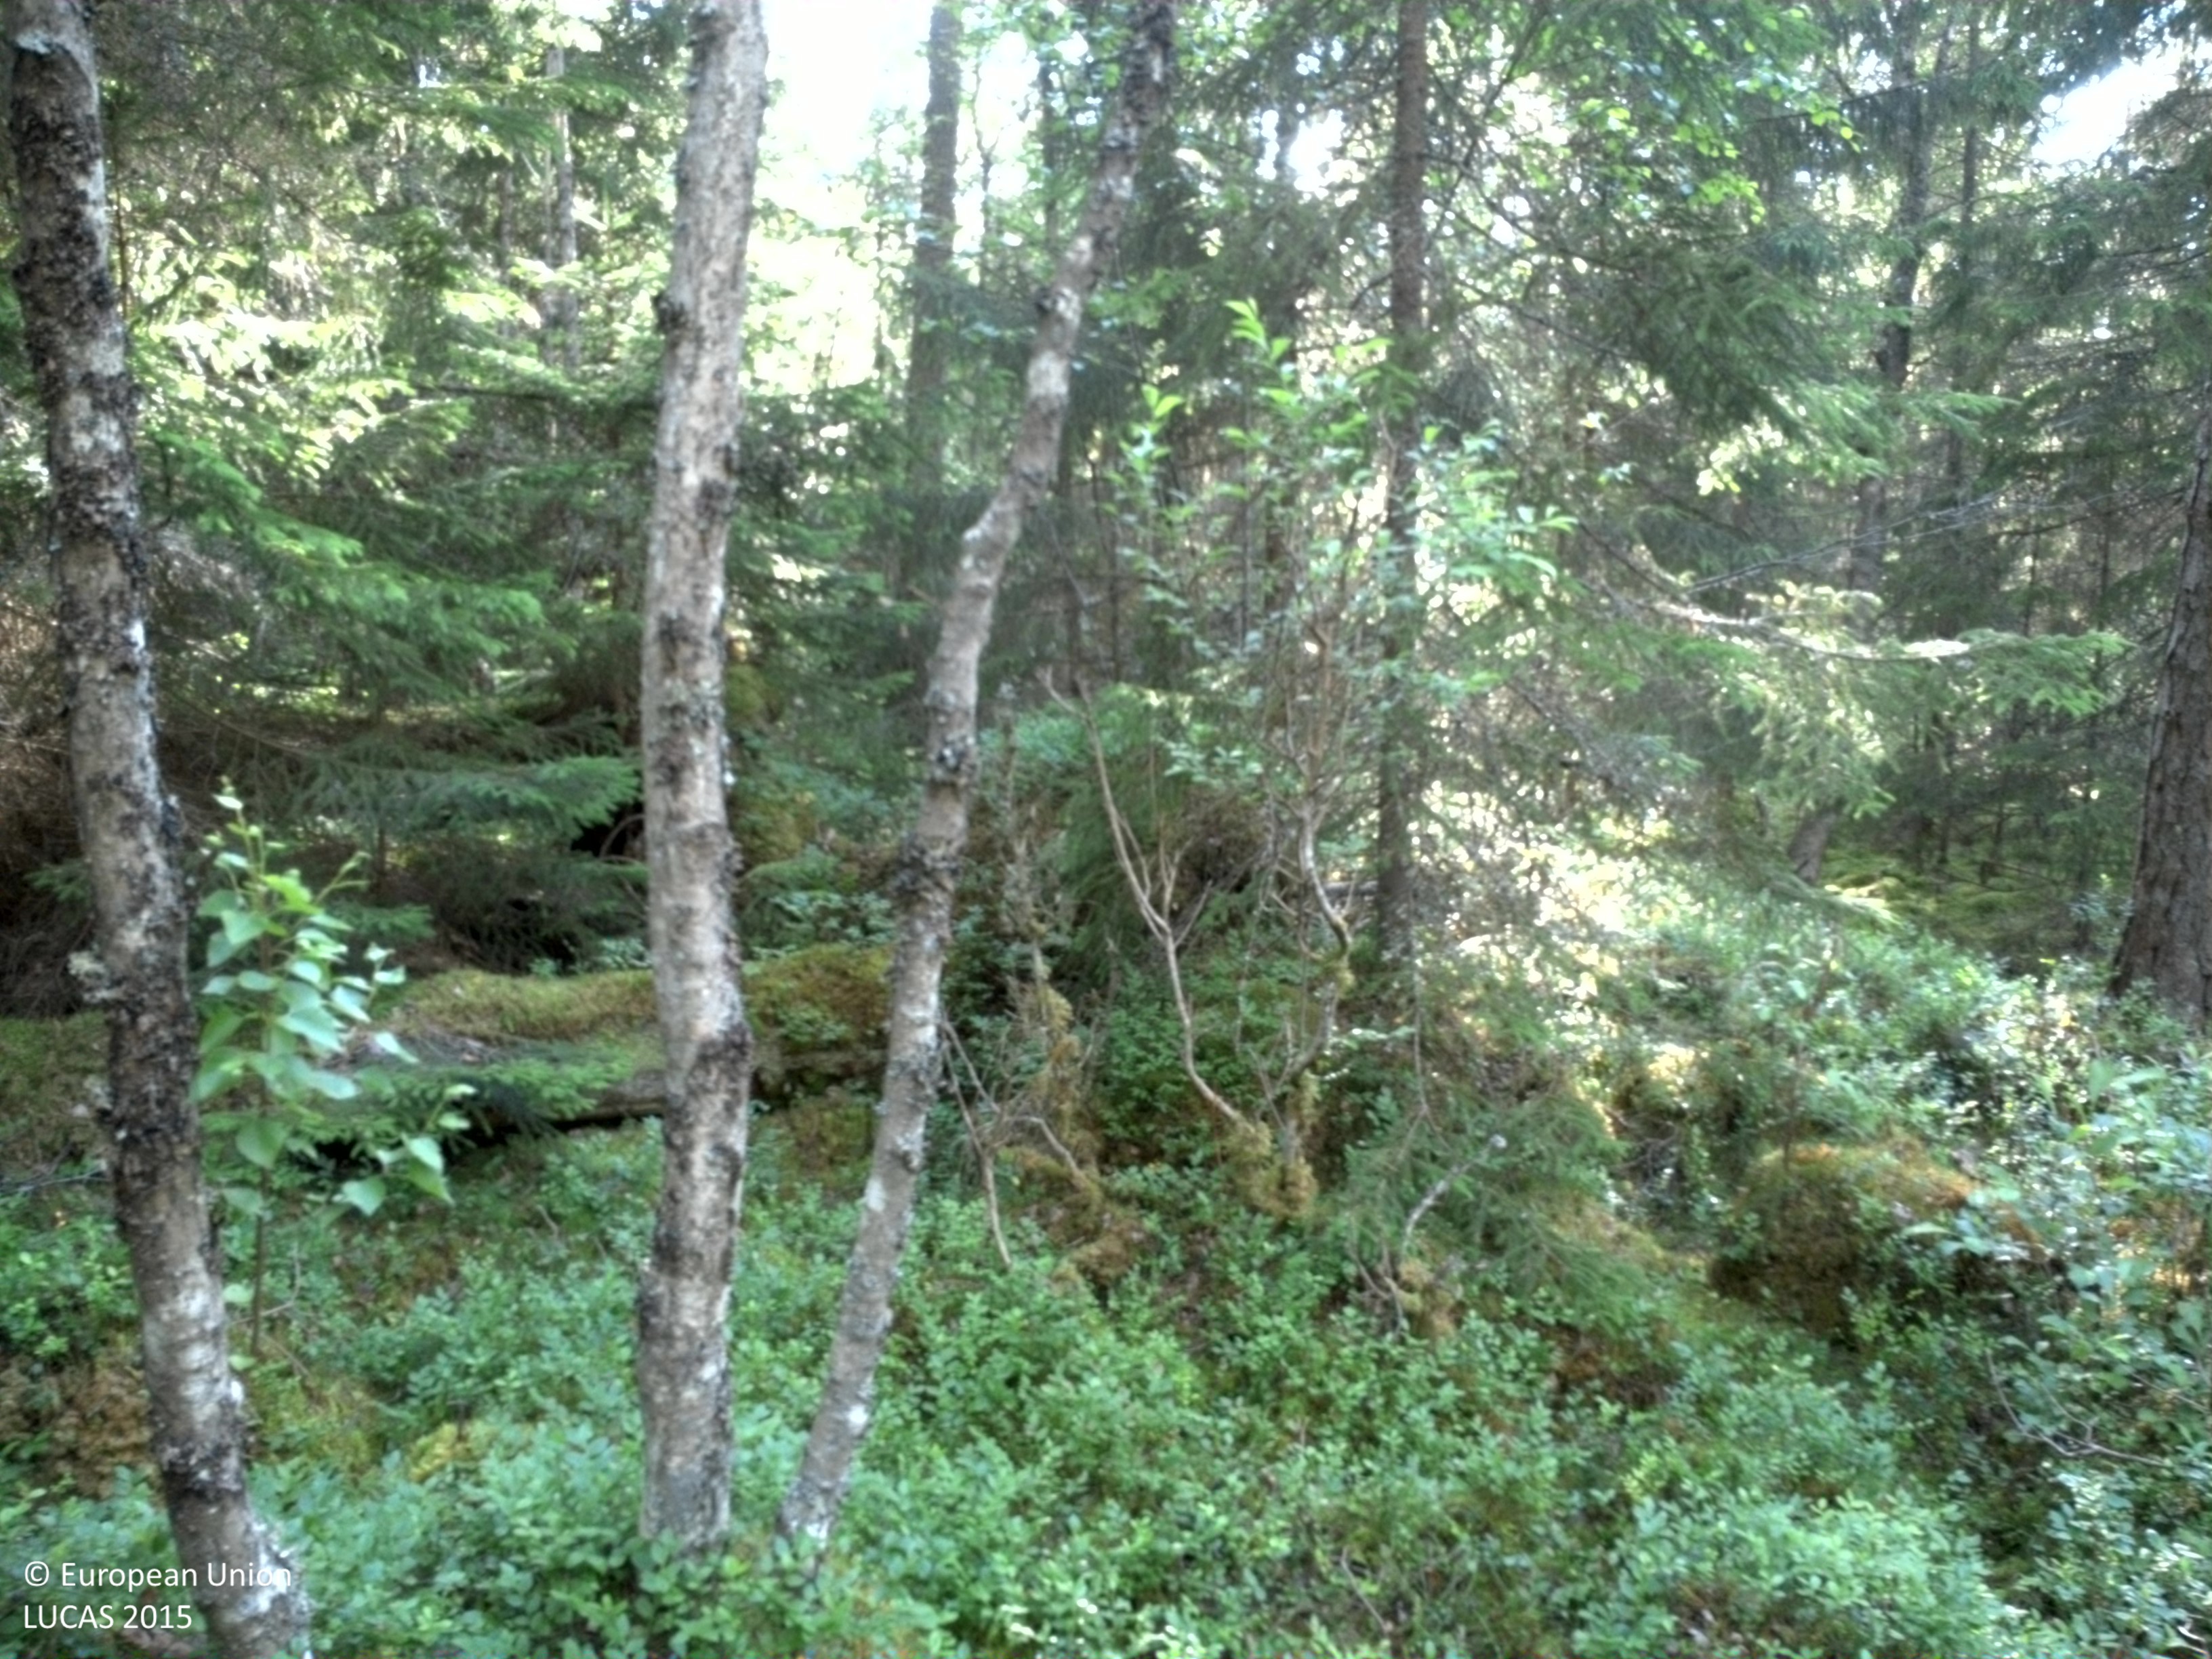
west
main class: Woodland
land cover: Pine dominated coniferous woodland
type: boreal forest
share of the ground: 50 - 75 %
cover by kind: coniferous forest trees 70 %, lichens and mosses 20 %, shrubs 10 %
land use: Forestry
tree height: > 5 m
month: July
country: SE
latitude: 57.7138
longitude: 14.4434
